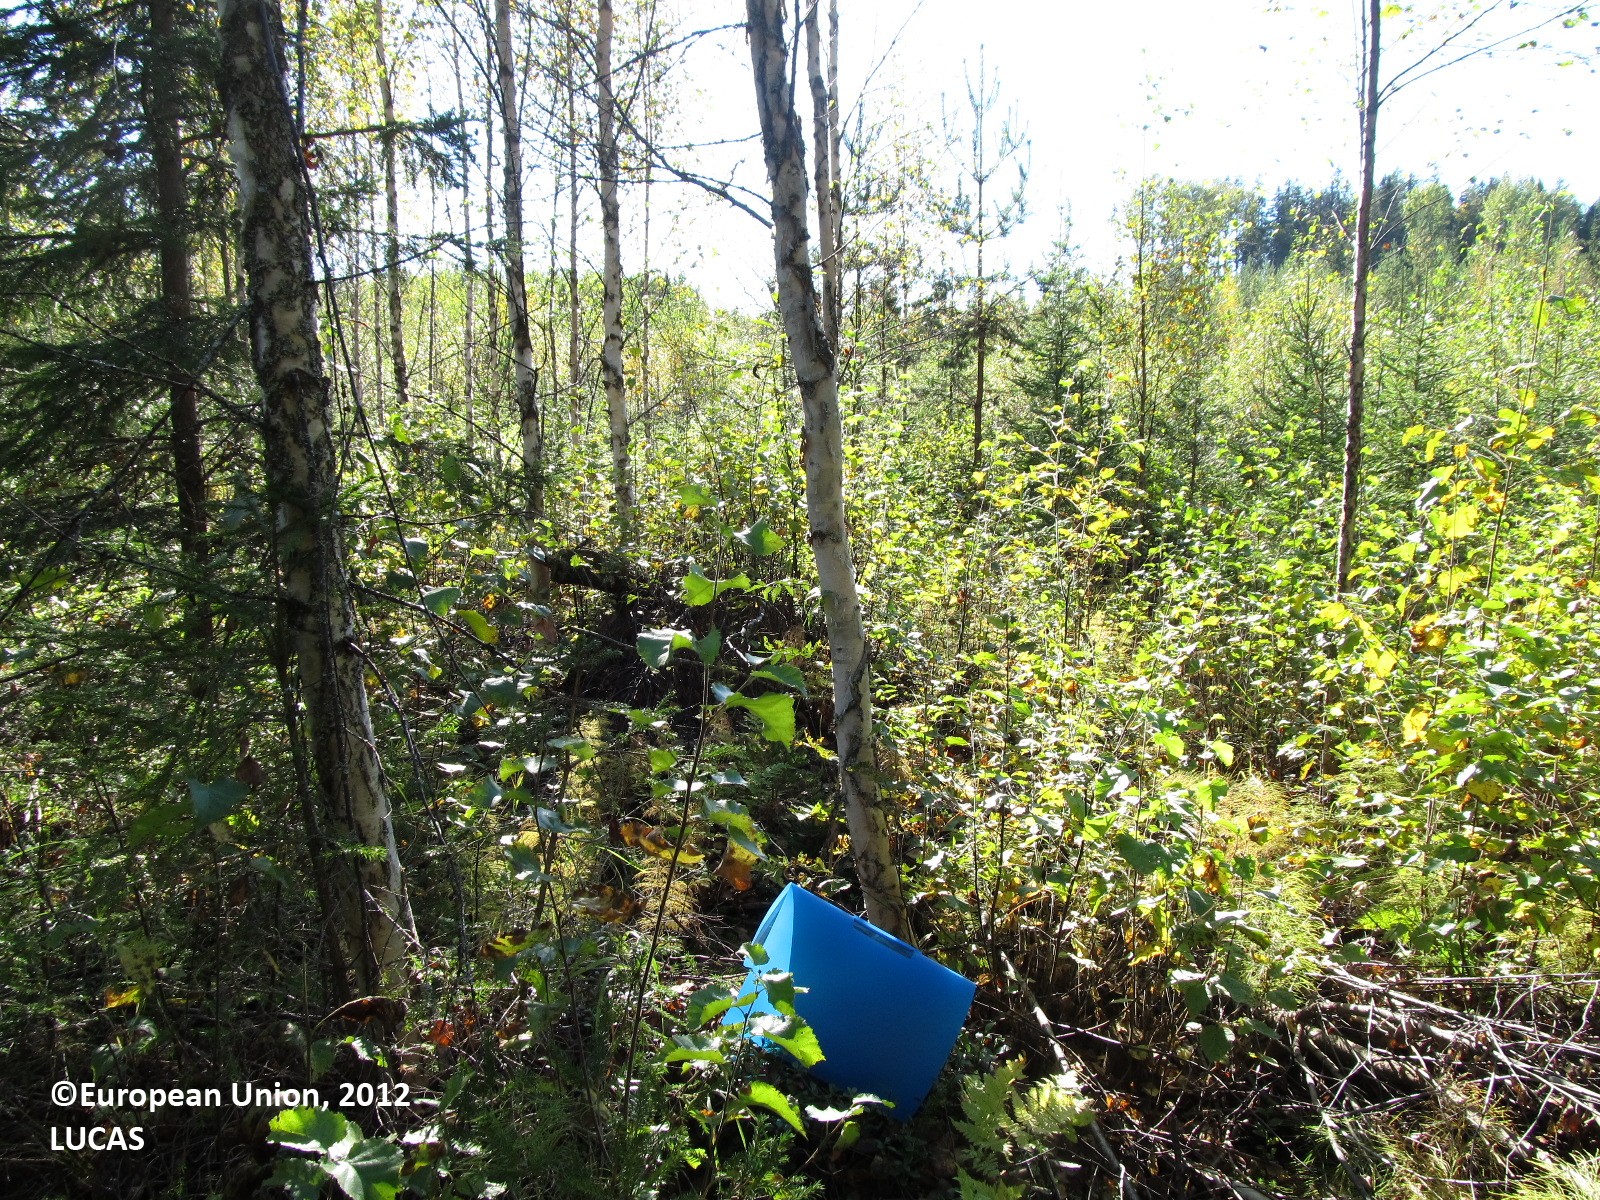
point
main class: Woodland
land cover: Spruce dominated mixed woodland
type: boreal forest
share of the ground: 50 - 75 %
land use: Forestry
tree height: > 5 m
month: September
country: FI
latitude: 62.4412
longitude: 28.3102
